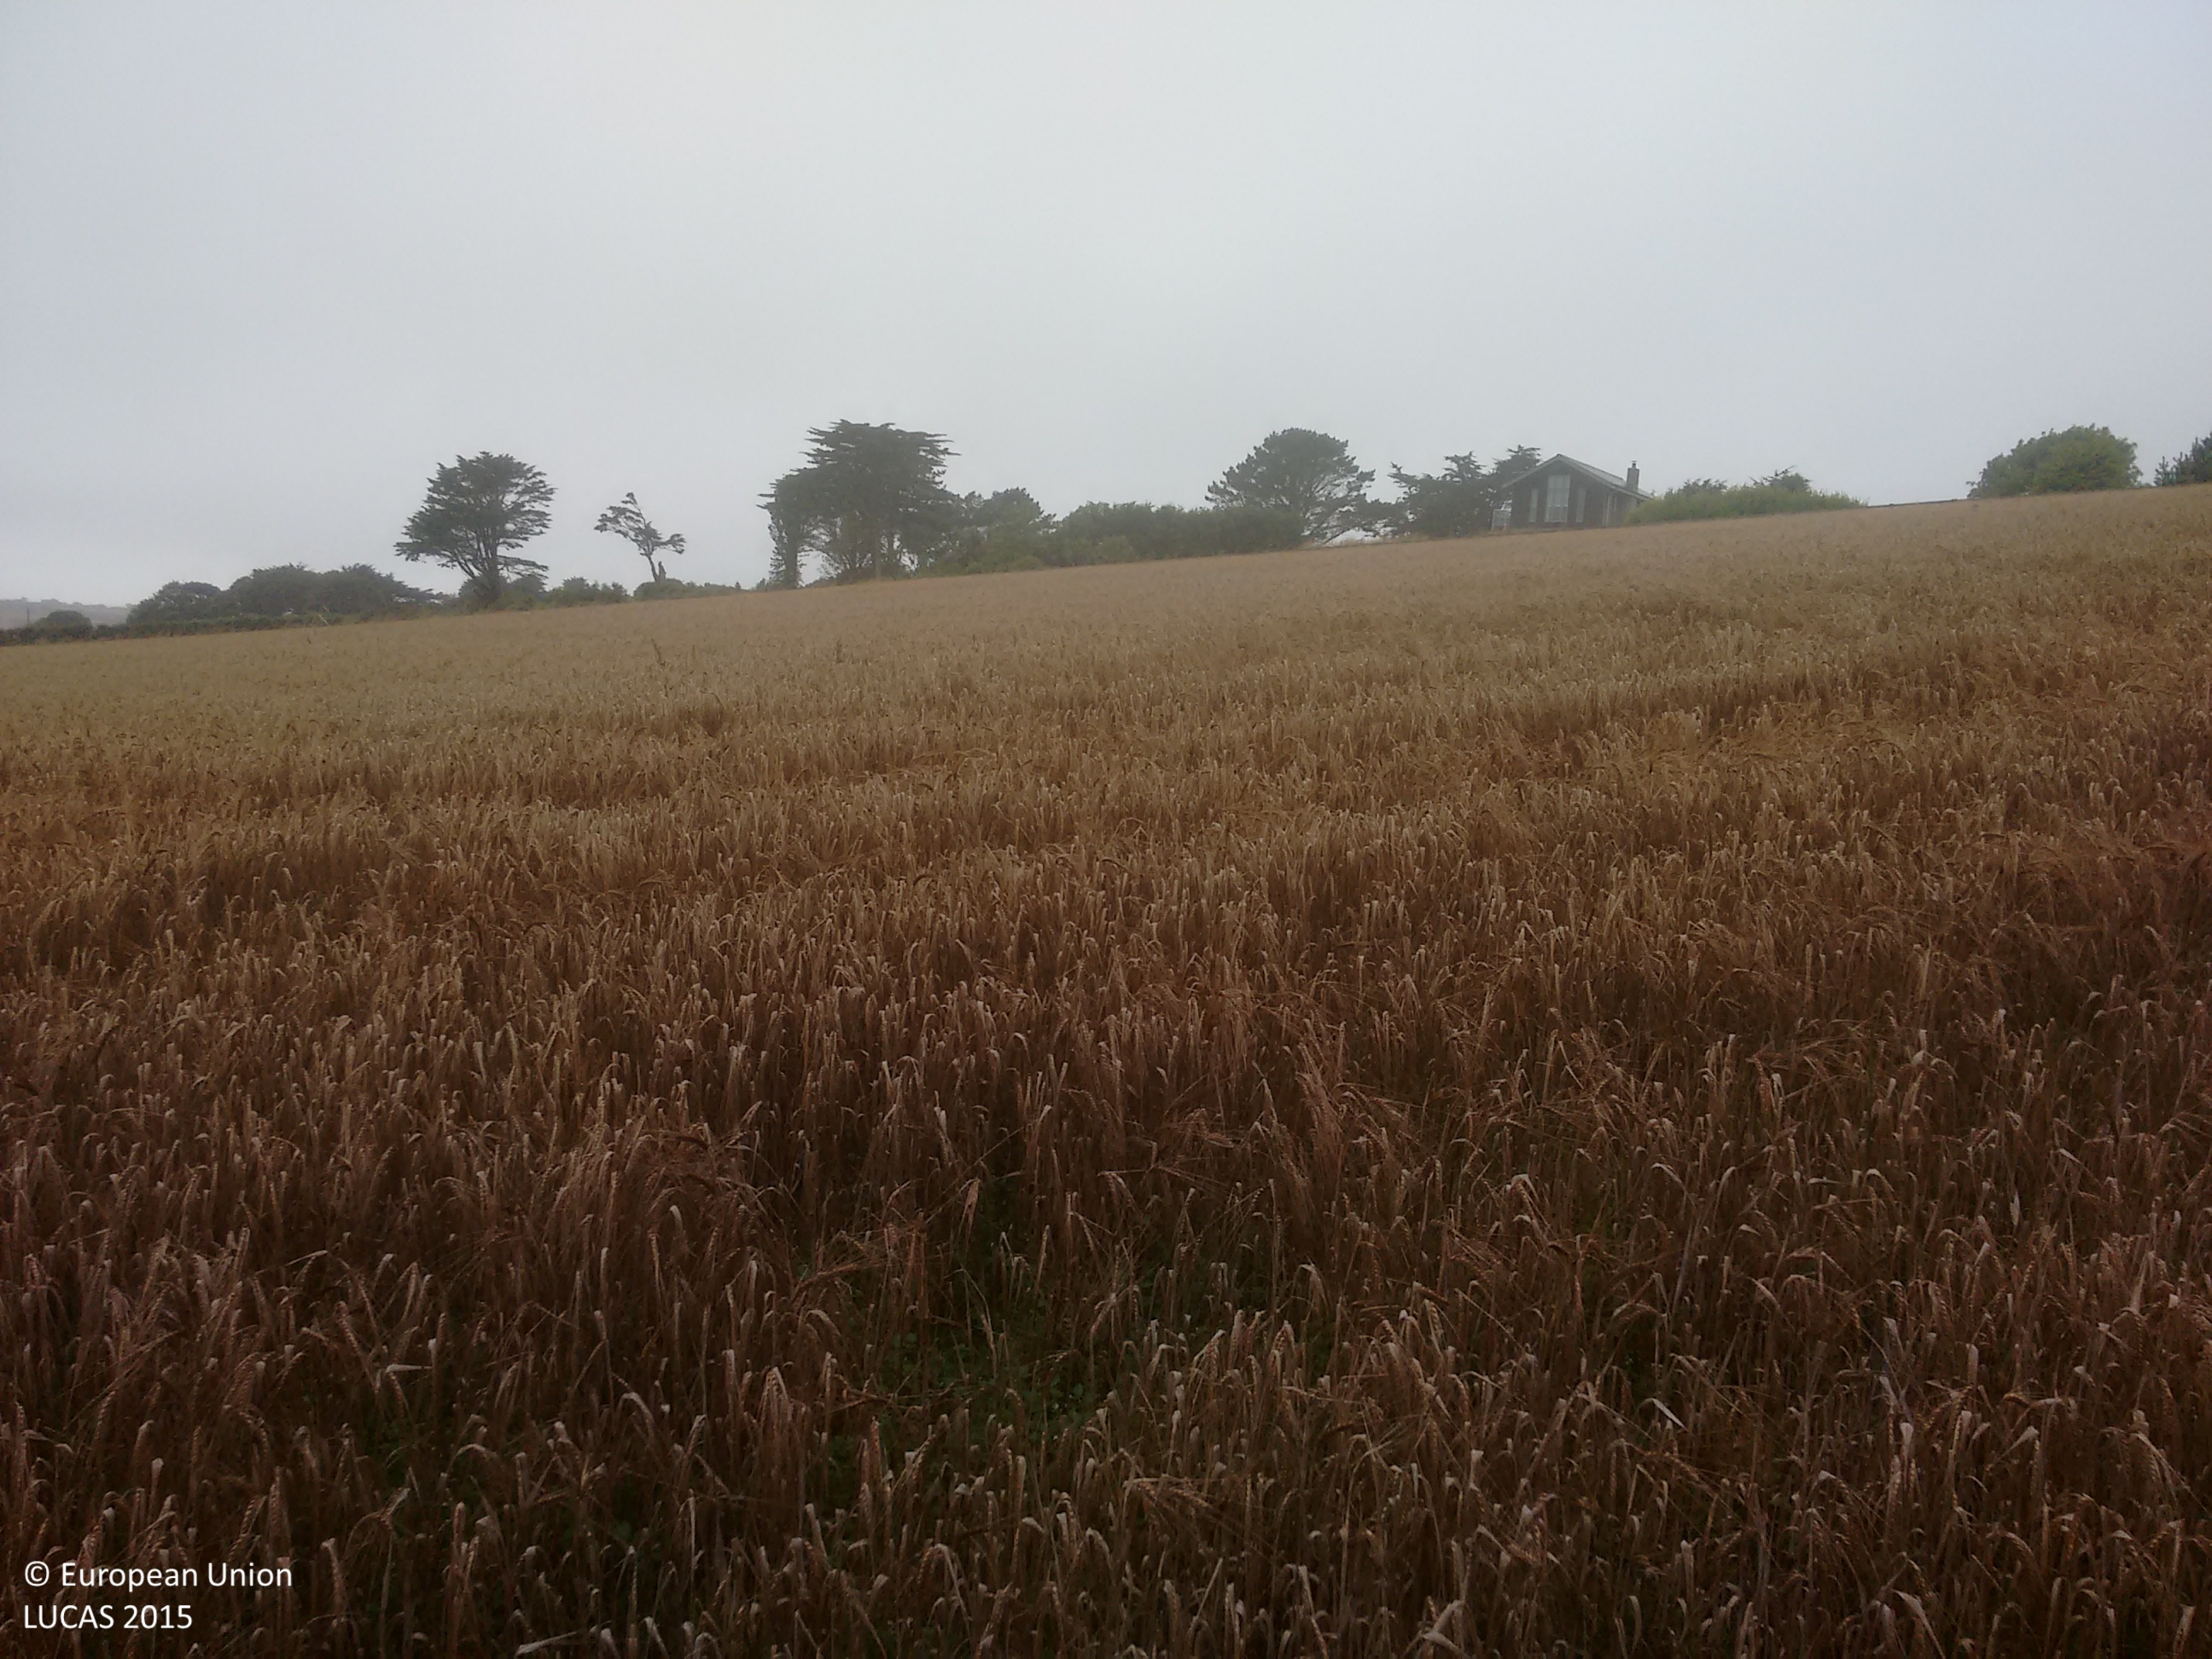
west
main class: Cropland
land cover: Barley
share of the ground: > 75 %
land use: Agriculture (excluding fallow land and kitchen gardens)
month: August
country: GB
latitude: 50.1154
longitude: -5.1525
